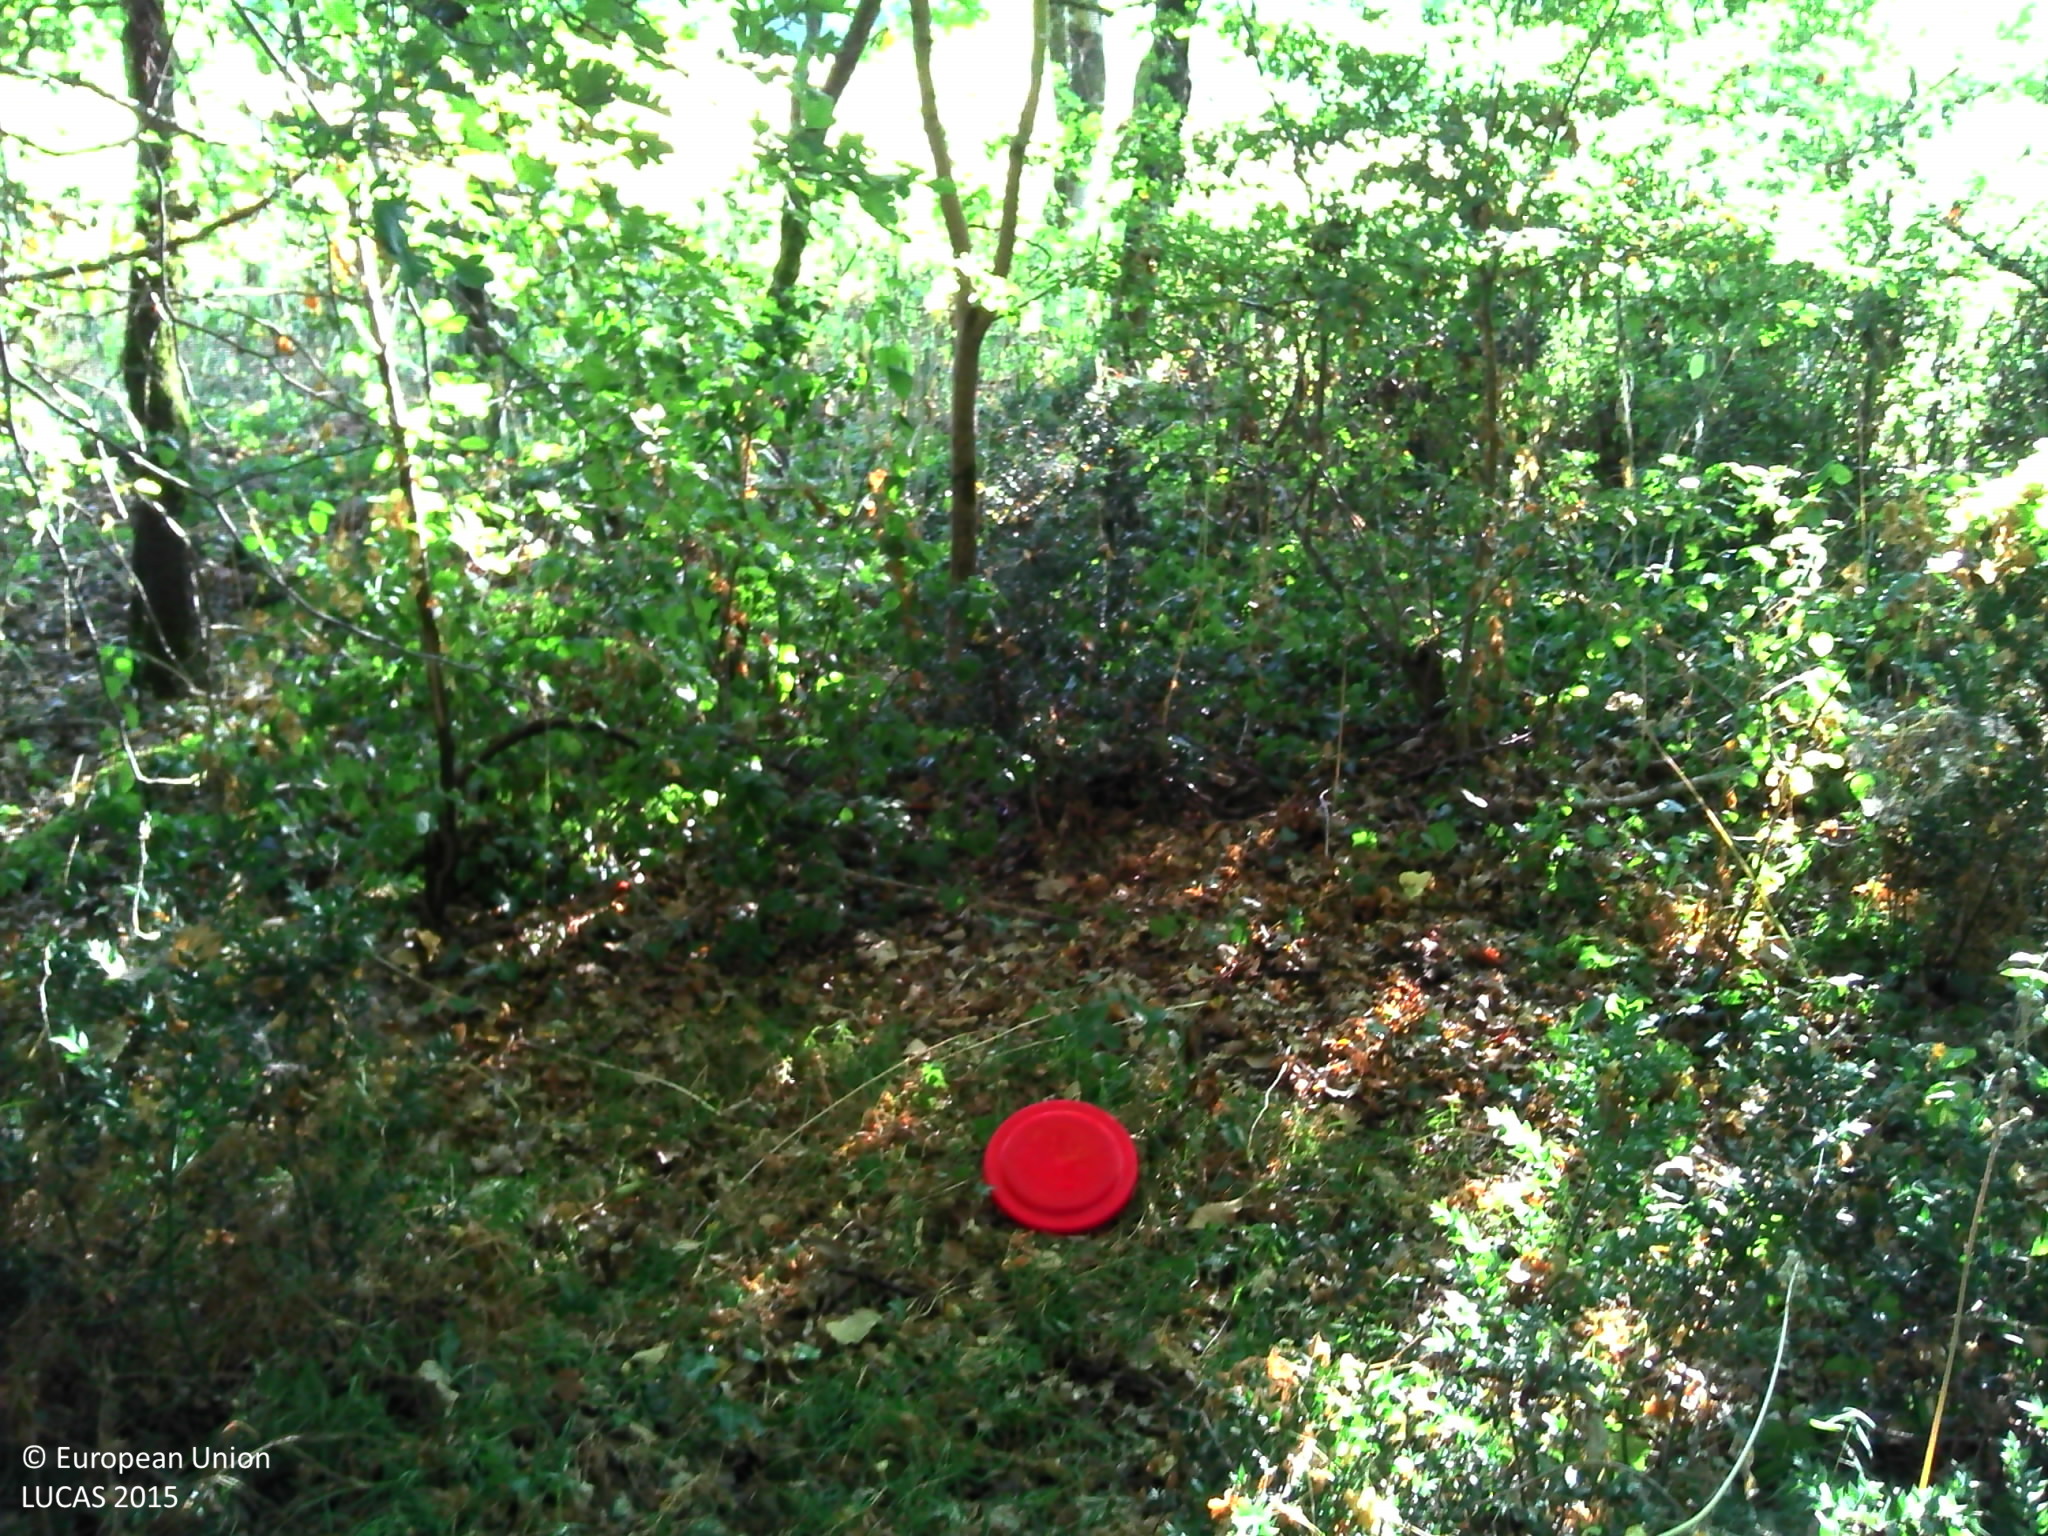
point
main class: Woodland
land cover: Broadleaved woodland
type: acidophilous oak and oak-birch forest
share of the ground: > 75 %
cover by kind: broadleaved forest trees 80 %, herbaceous plants 10 %, shrubs 5 %, lichens and mosses 5 %
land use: Forestry
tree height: > 5 m
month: July
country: FR
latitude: 44.7202
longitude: 0.5863
